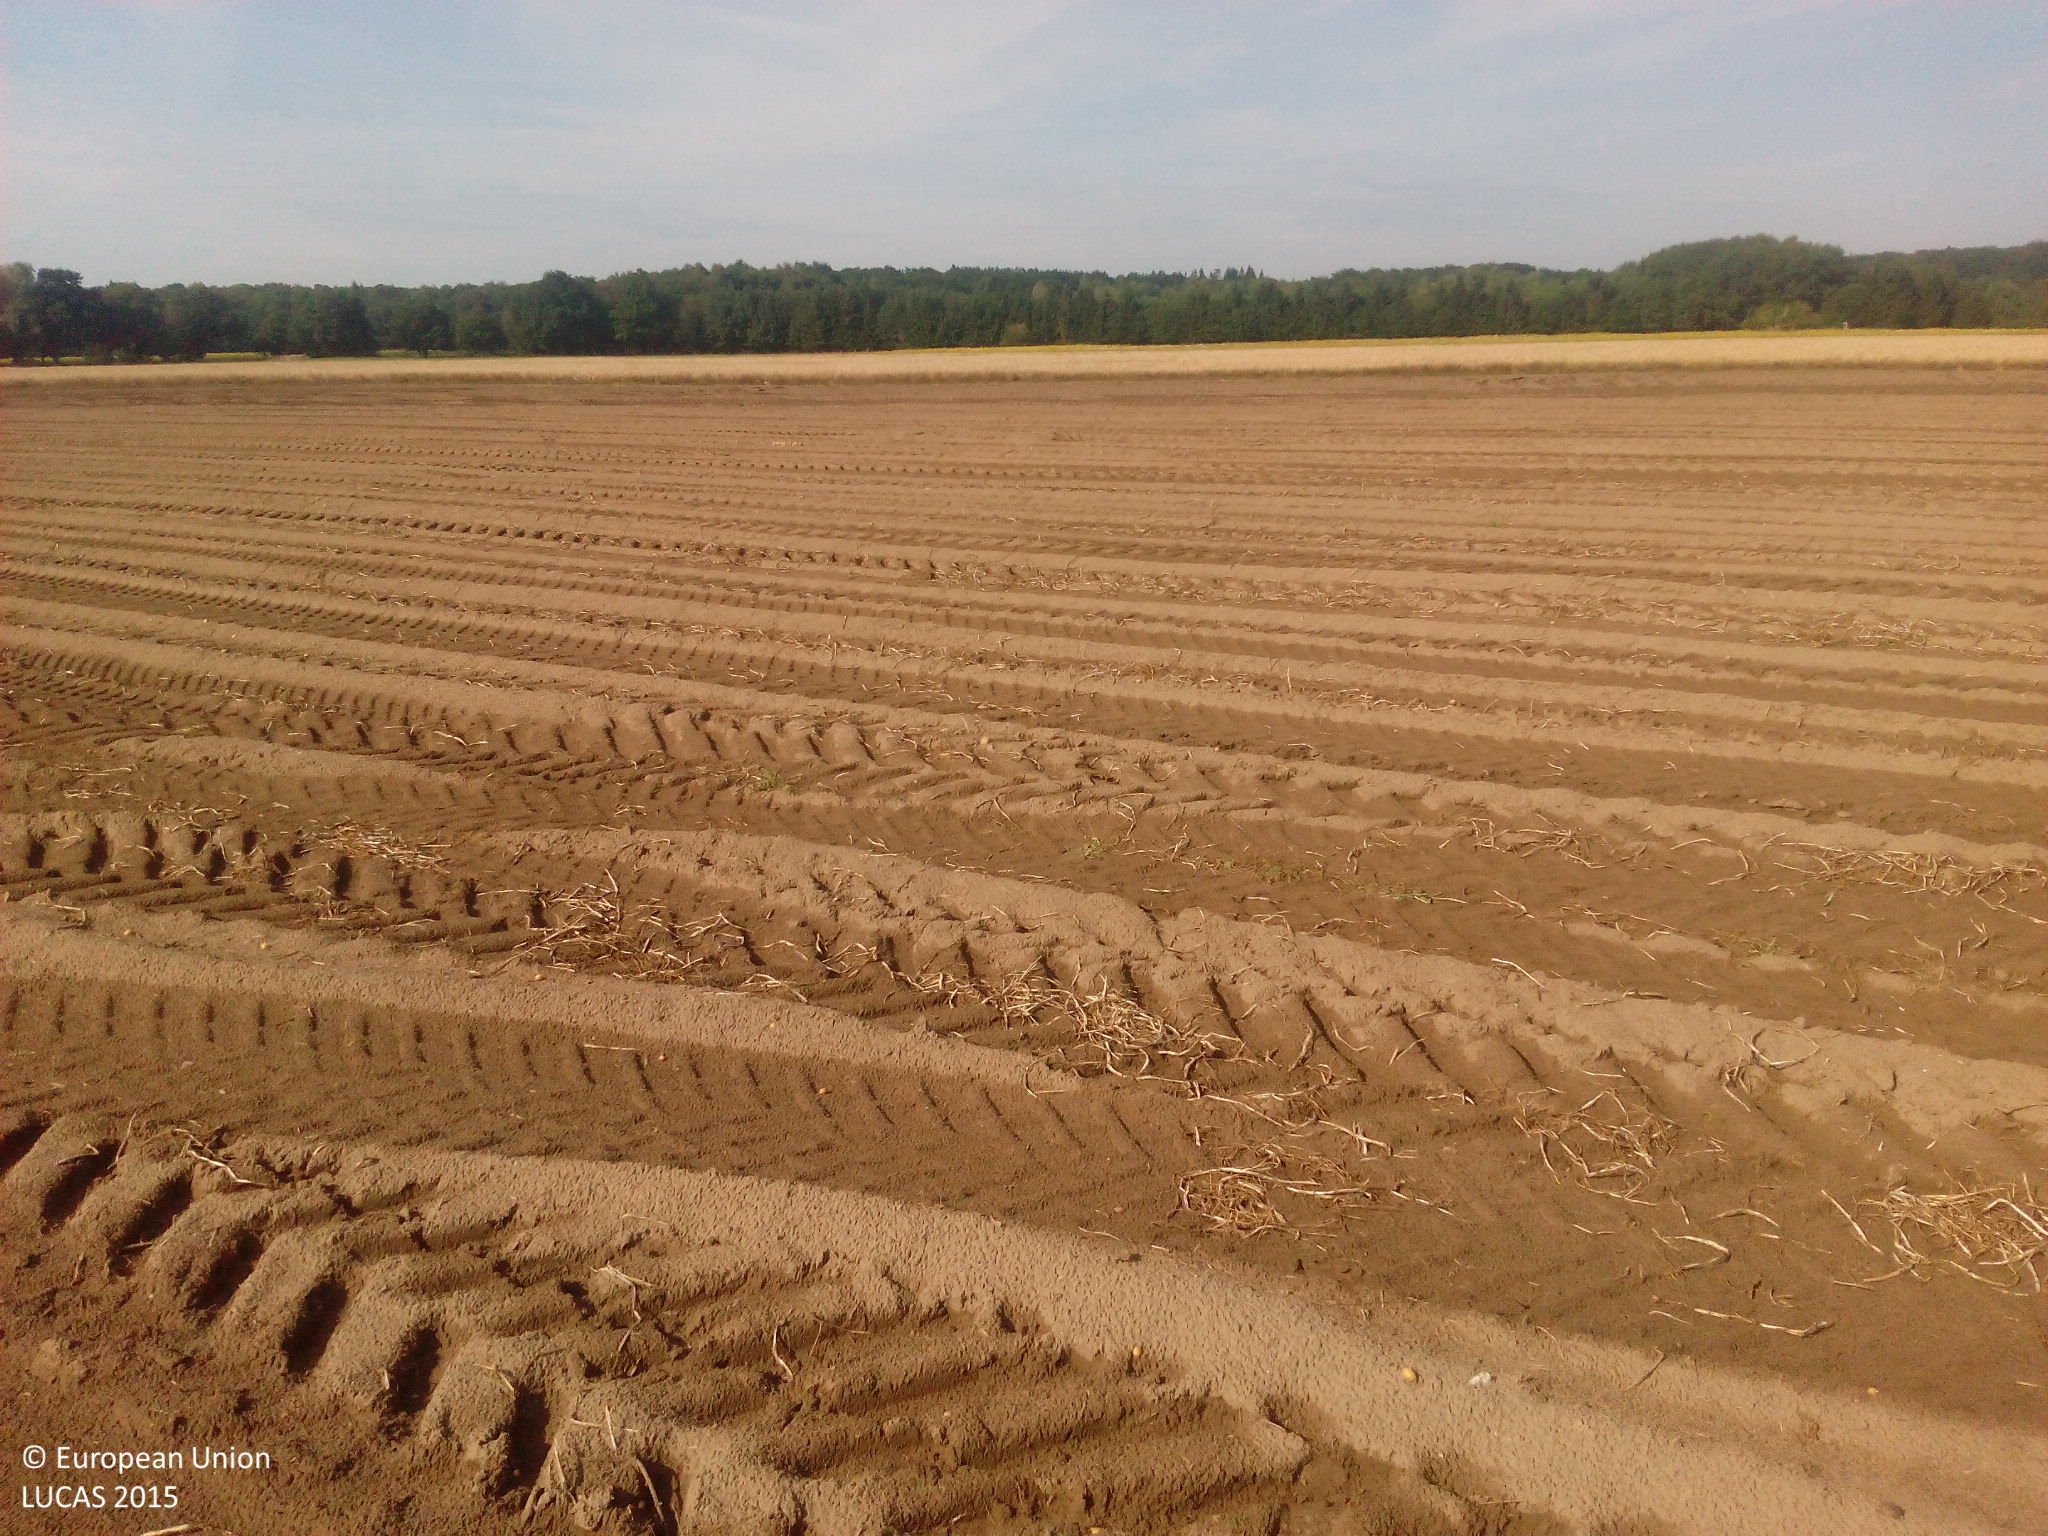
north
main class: Cropland
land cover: Potatoes
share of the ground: < 10 %
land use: Agriculture (excluding fallow land and kitchen gardens)
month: August
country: DE
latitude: 54.1809
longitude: 12.7111
